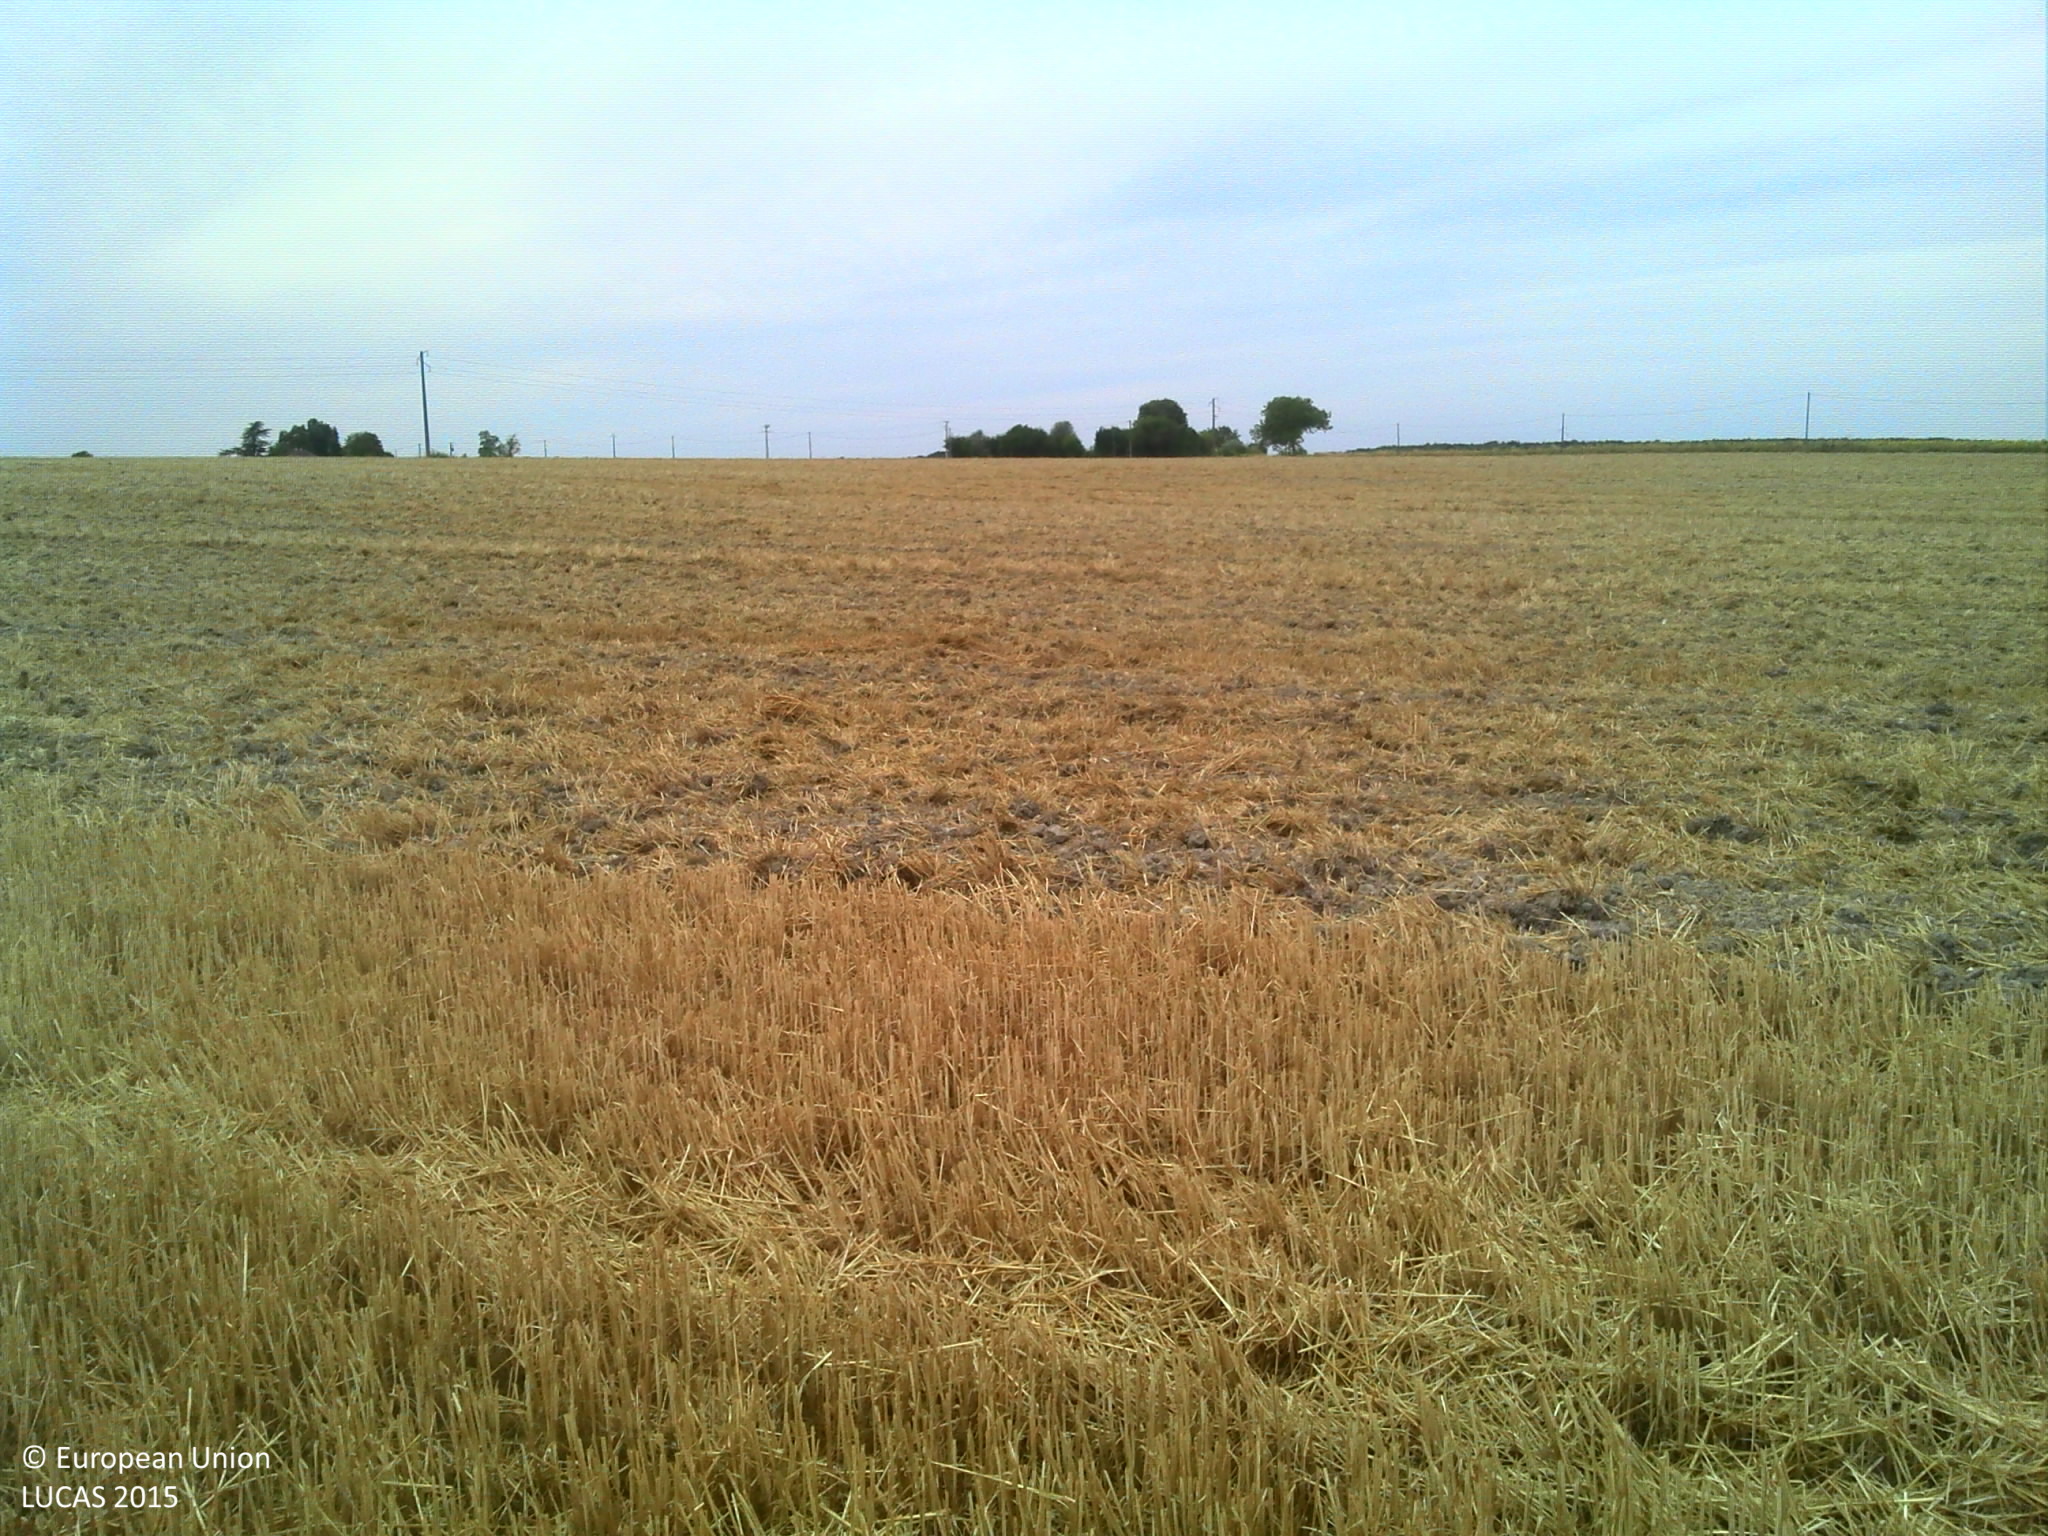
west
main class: Cropland
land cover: Common wheat
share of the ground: > 75 %
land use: Agriculture (excluding fallow land and kitchen gardens)
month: July
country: FR
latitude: 47.1125
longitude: 0.3716
